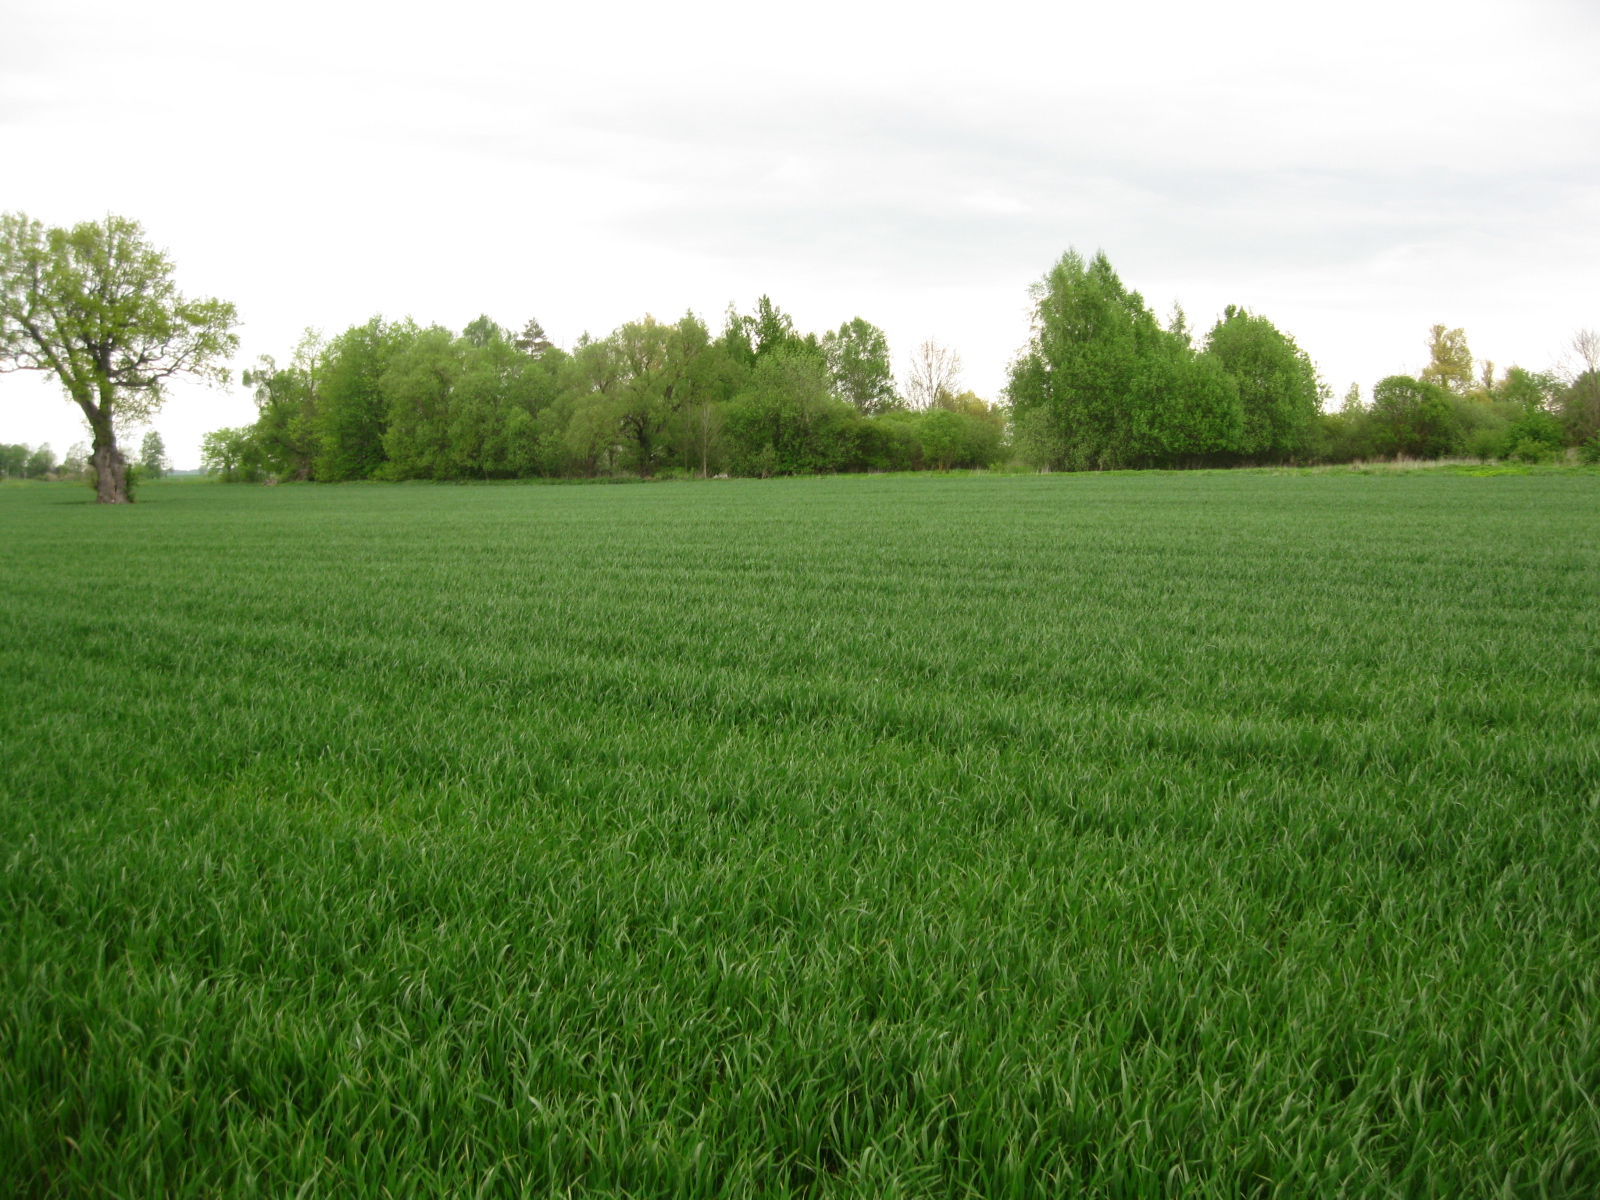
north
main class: Cropland
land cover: Common wheat
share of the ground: > 75 %
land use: Agriculture (excluding fallow land and kitchen gardens)
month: May
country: LT
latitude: 56.2453
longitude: 23.4201
